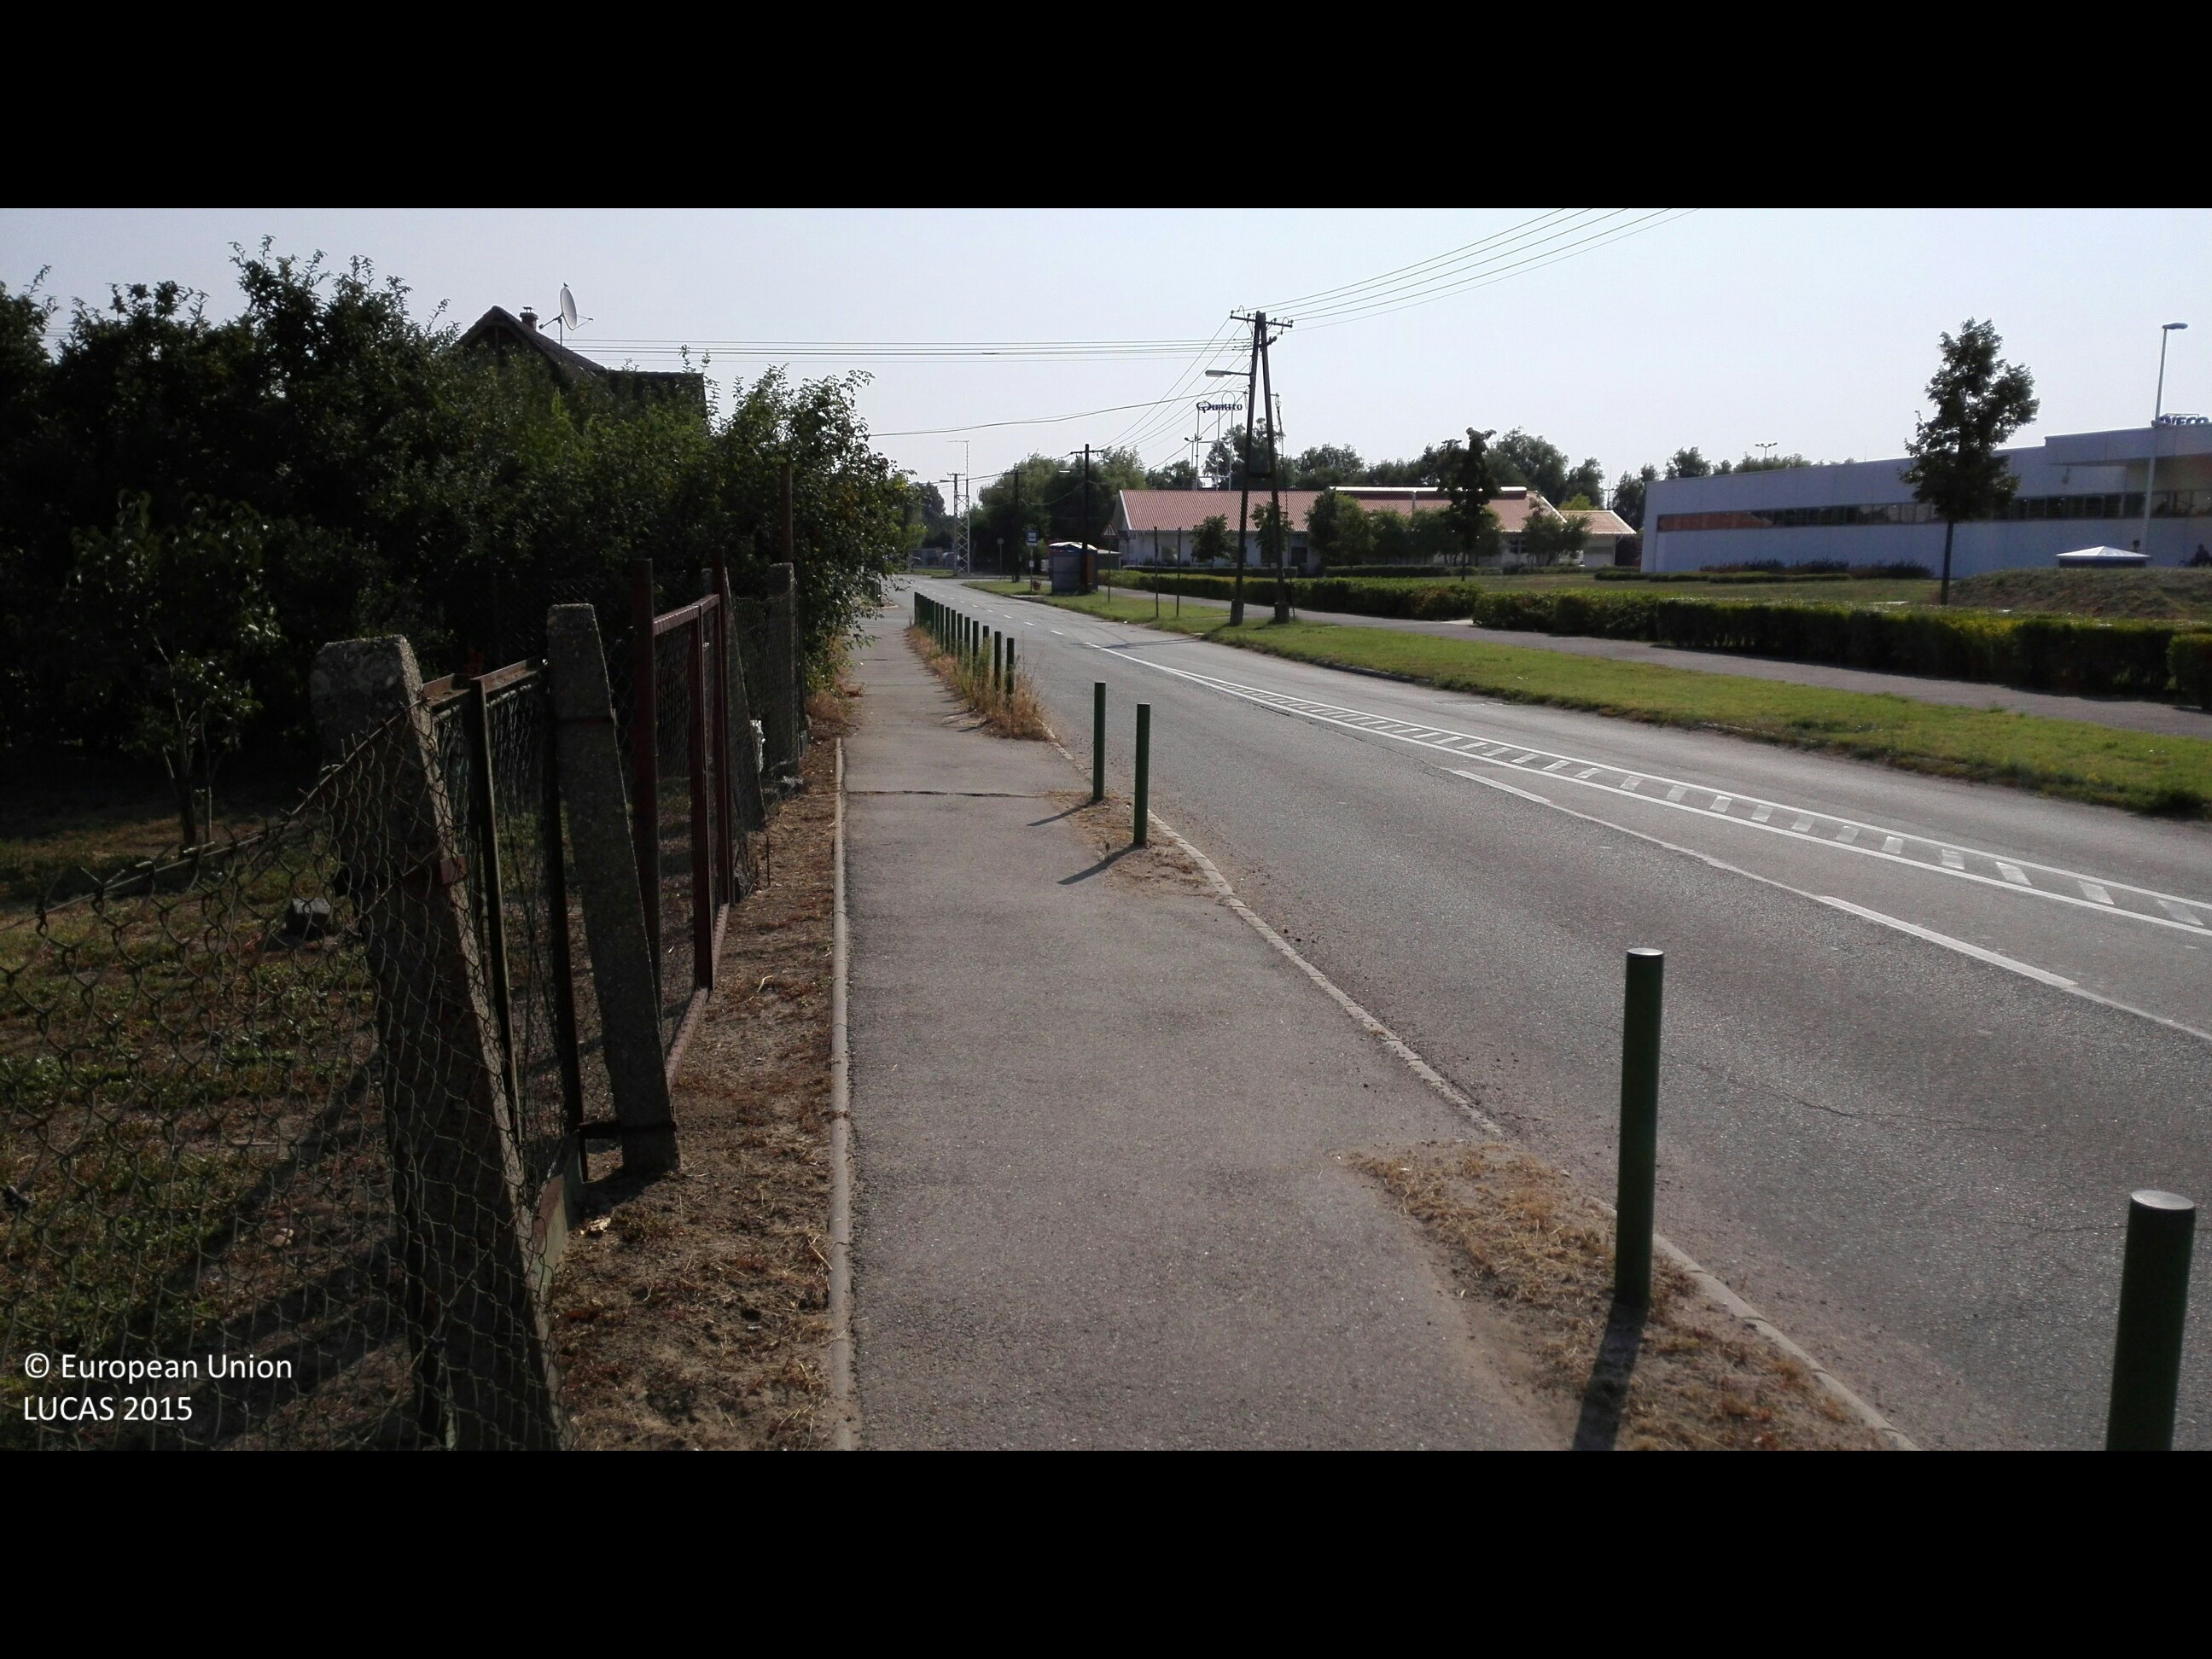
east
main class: Grassland
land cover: Grassland with sparse tree/shrub cover
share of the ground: > 75 %
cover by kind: herbaceous plants 95 %, broadleaved forest trees 5 %
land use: Residential
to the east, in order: Grassland with sparse tree/shrub cover; Artificial constructions in urban areas
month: August
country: HU
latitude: 47.4963
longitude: 21.6330
